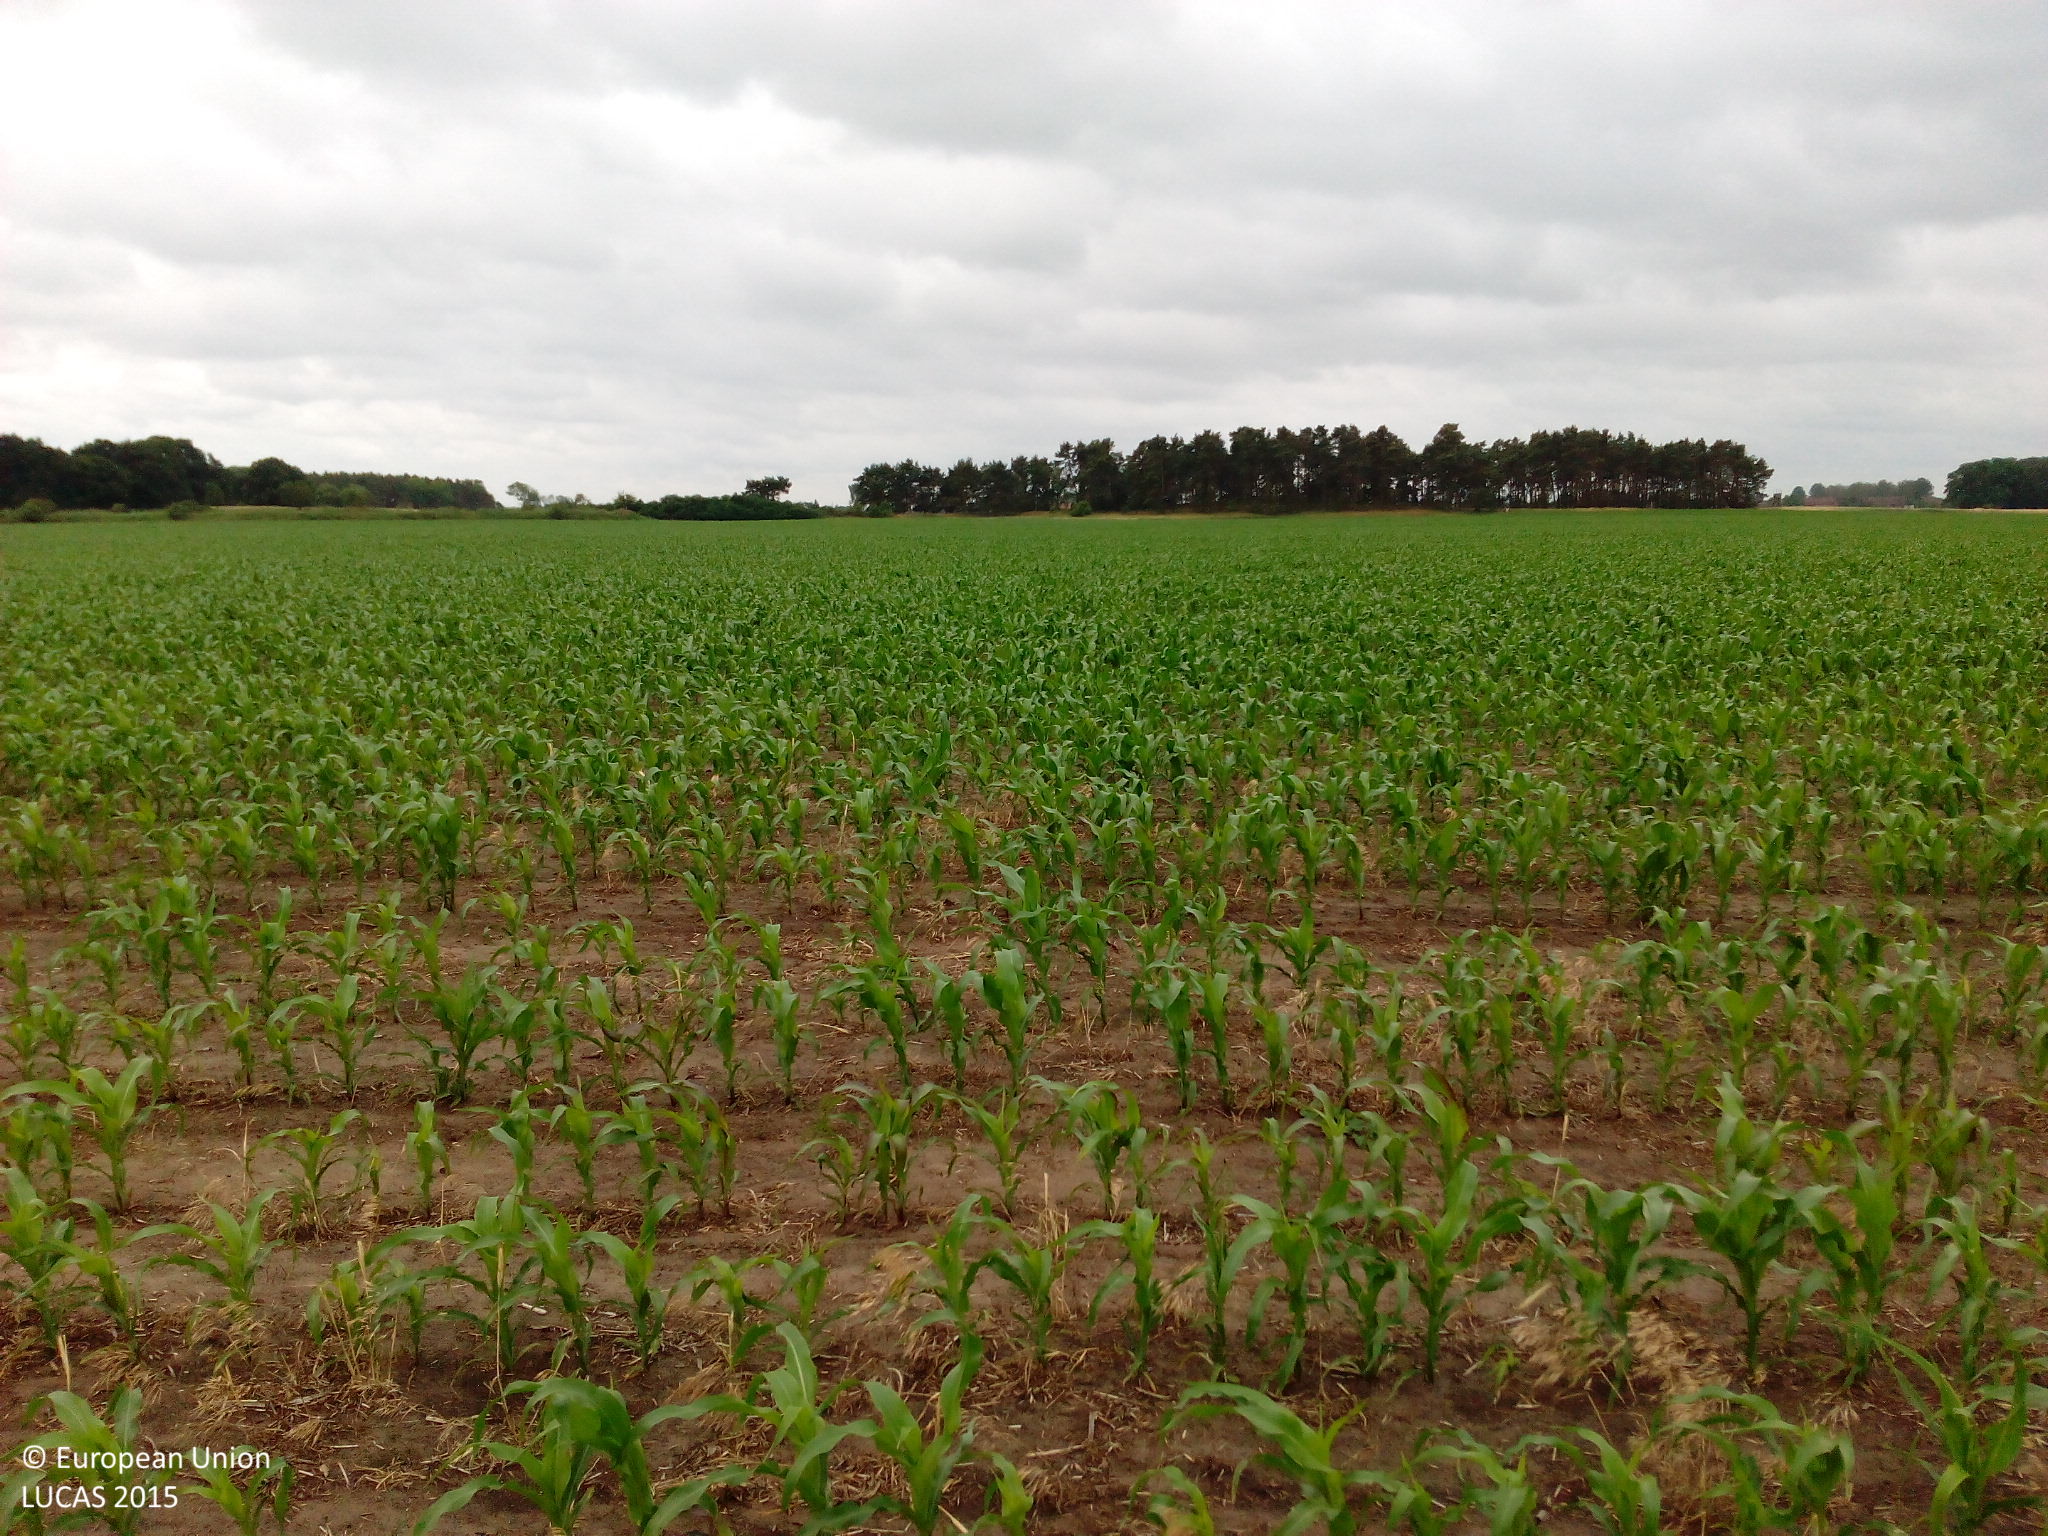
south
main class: Cropland
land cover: Maize
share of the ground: < 10 %
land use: Agriculture (excluding fallow land and kitchen gardens)
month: June
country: DE
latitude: 52.3573
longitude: 12.1874
